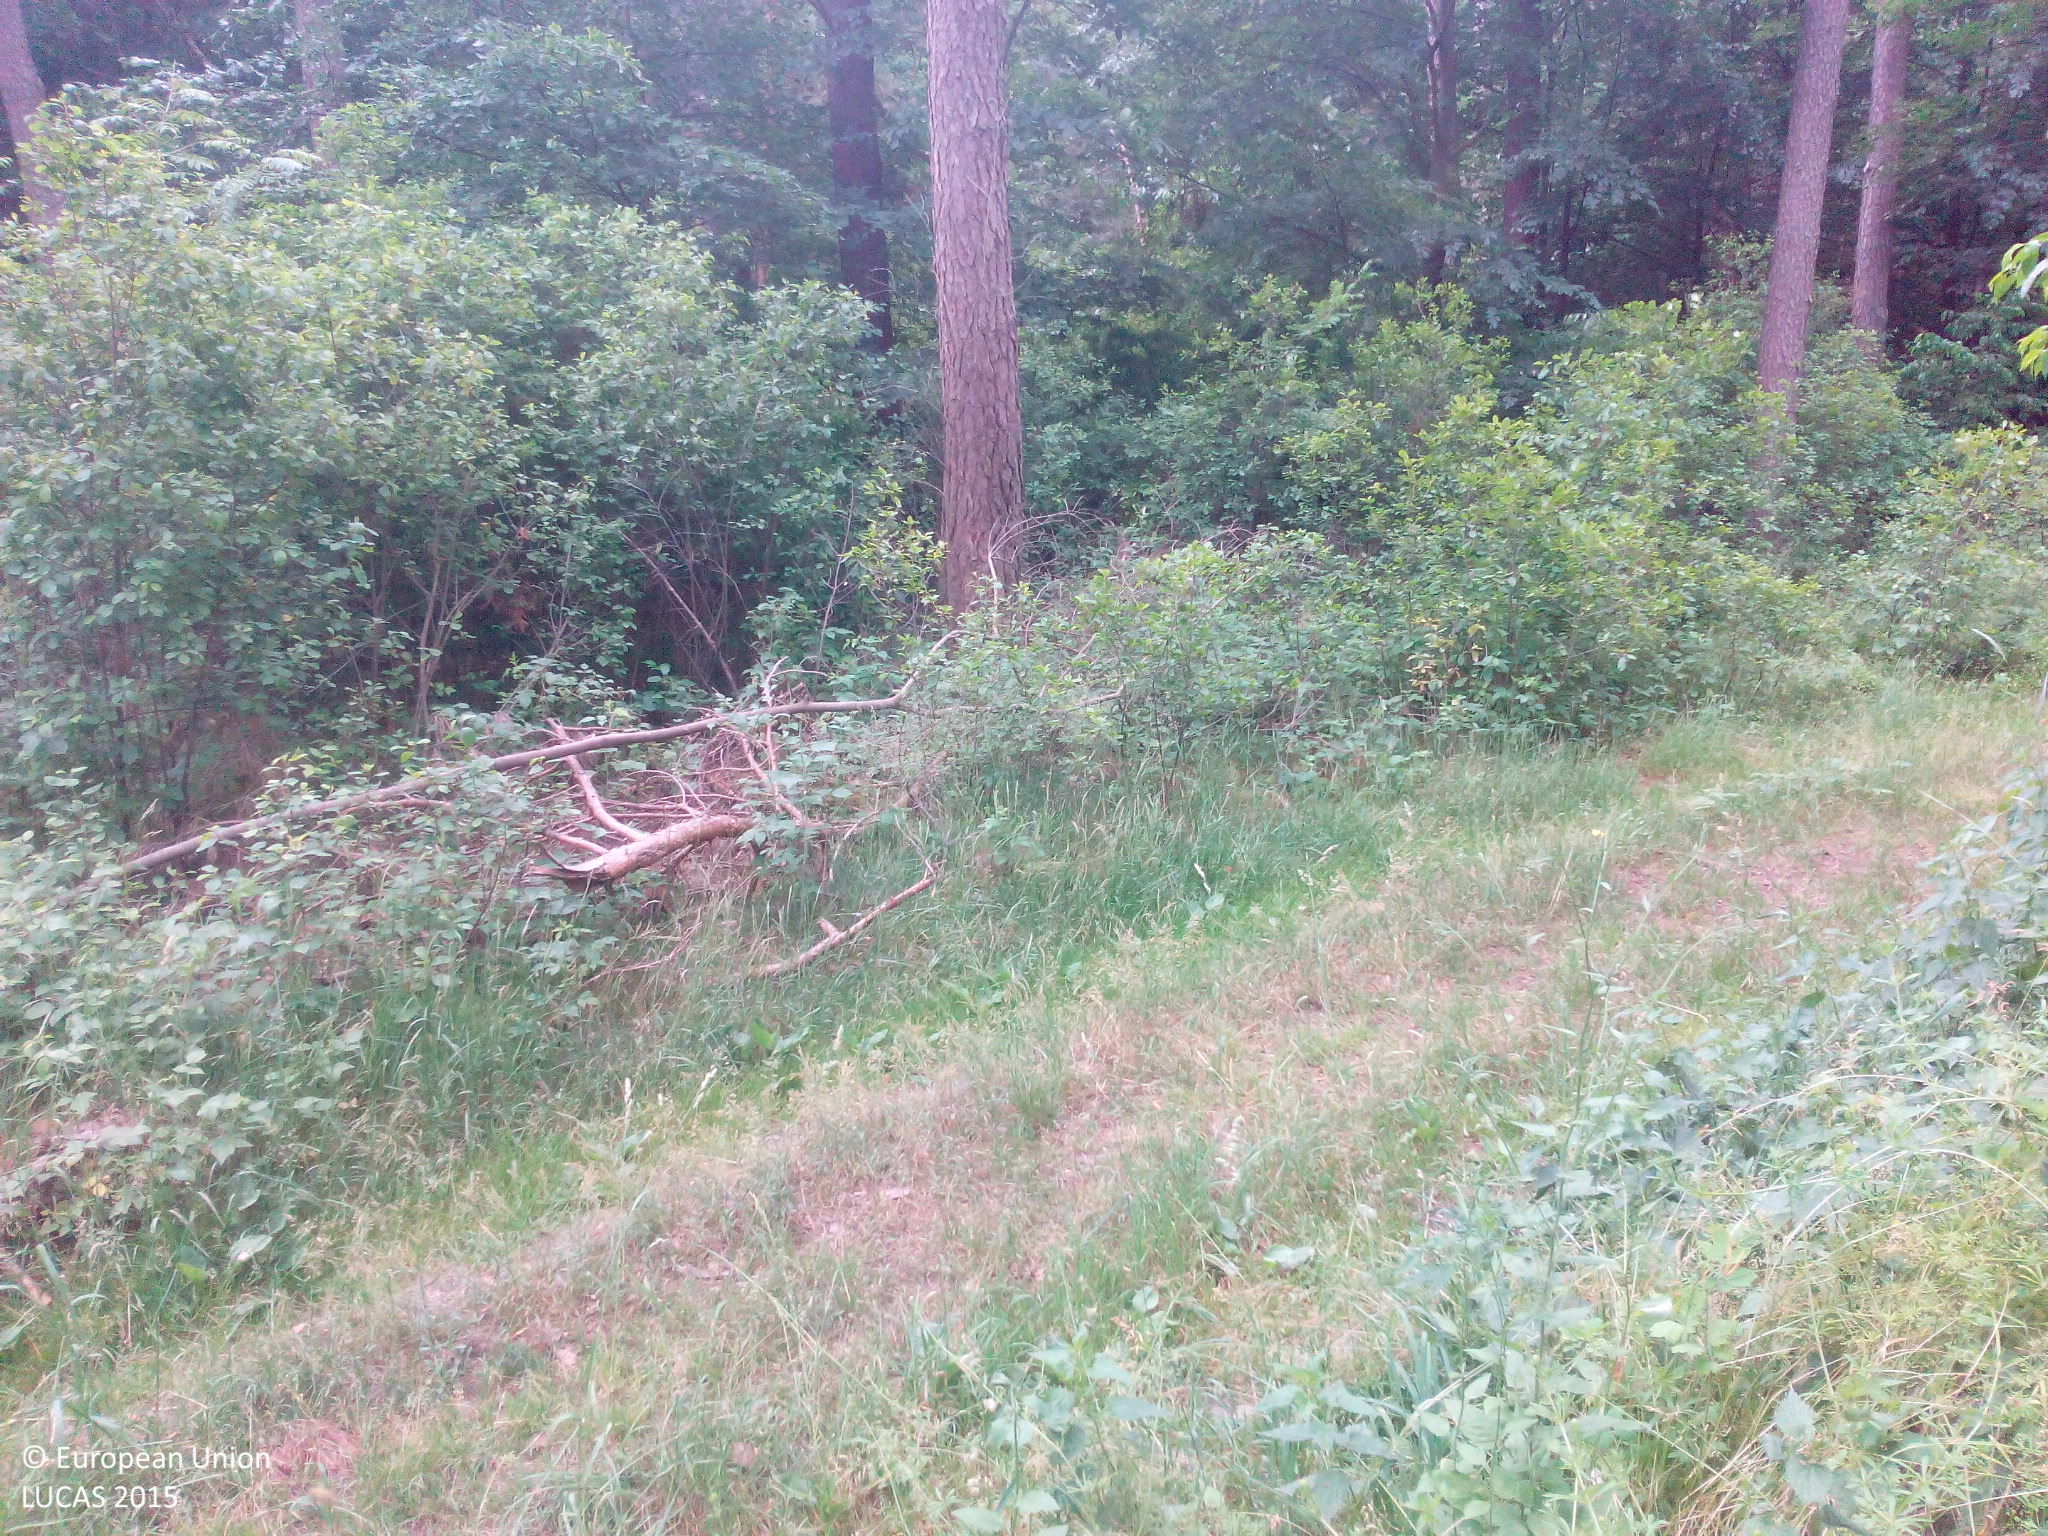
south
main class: Woodland
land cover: Pine dominated coniferous woodland
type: hemiboreal forest and nemoral coniferous forest and mixed broadleaved-coniferous forest
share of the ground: 50 - 75 %
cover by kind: coniferous forest trees 70 %, herbaceous plants 20 %, shrubs 10 %
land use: Forestry
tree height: > 5 m
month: June
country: DE
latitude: 49.2093
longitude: 10.9193
